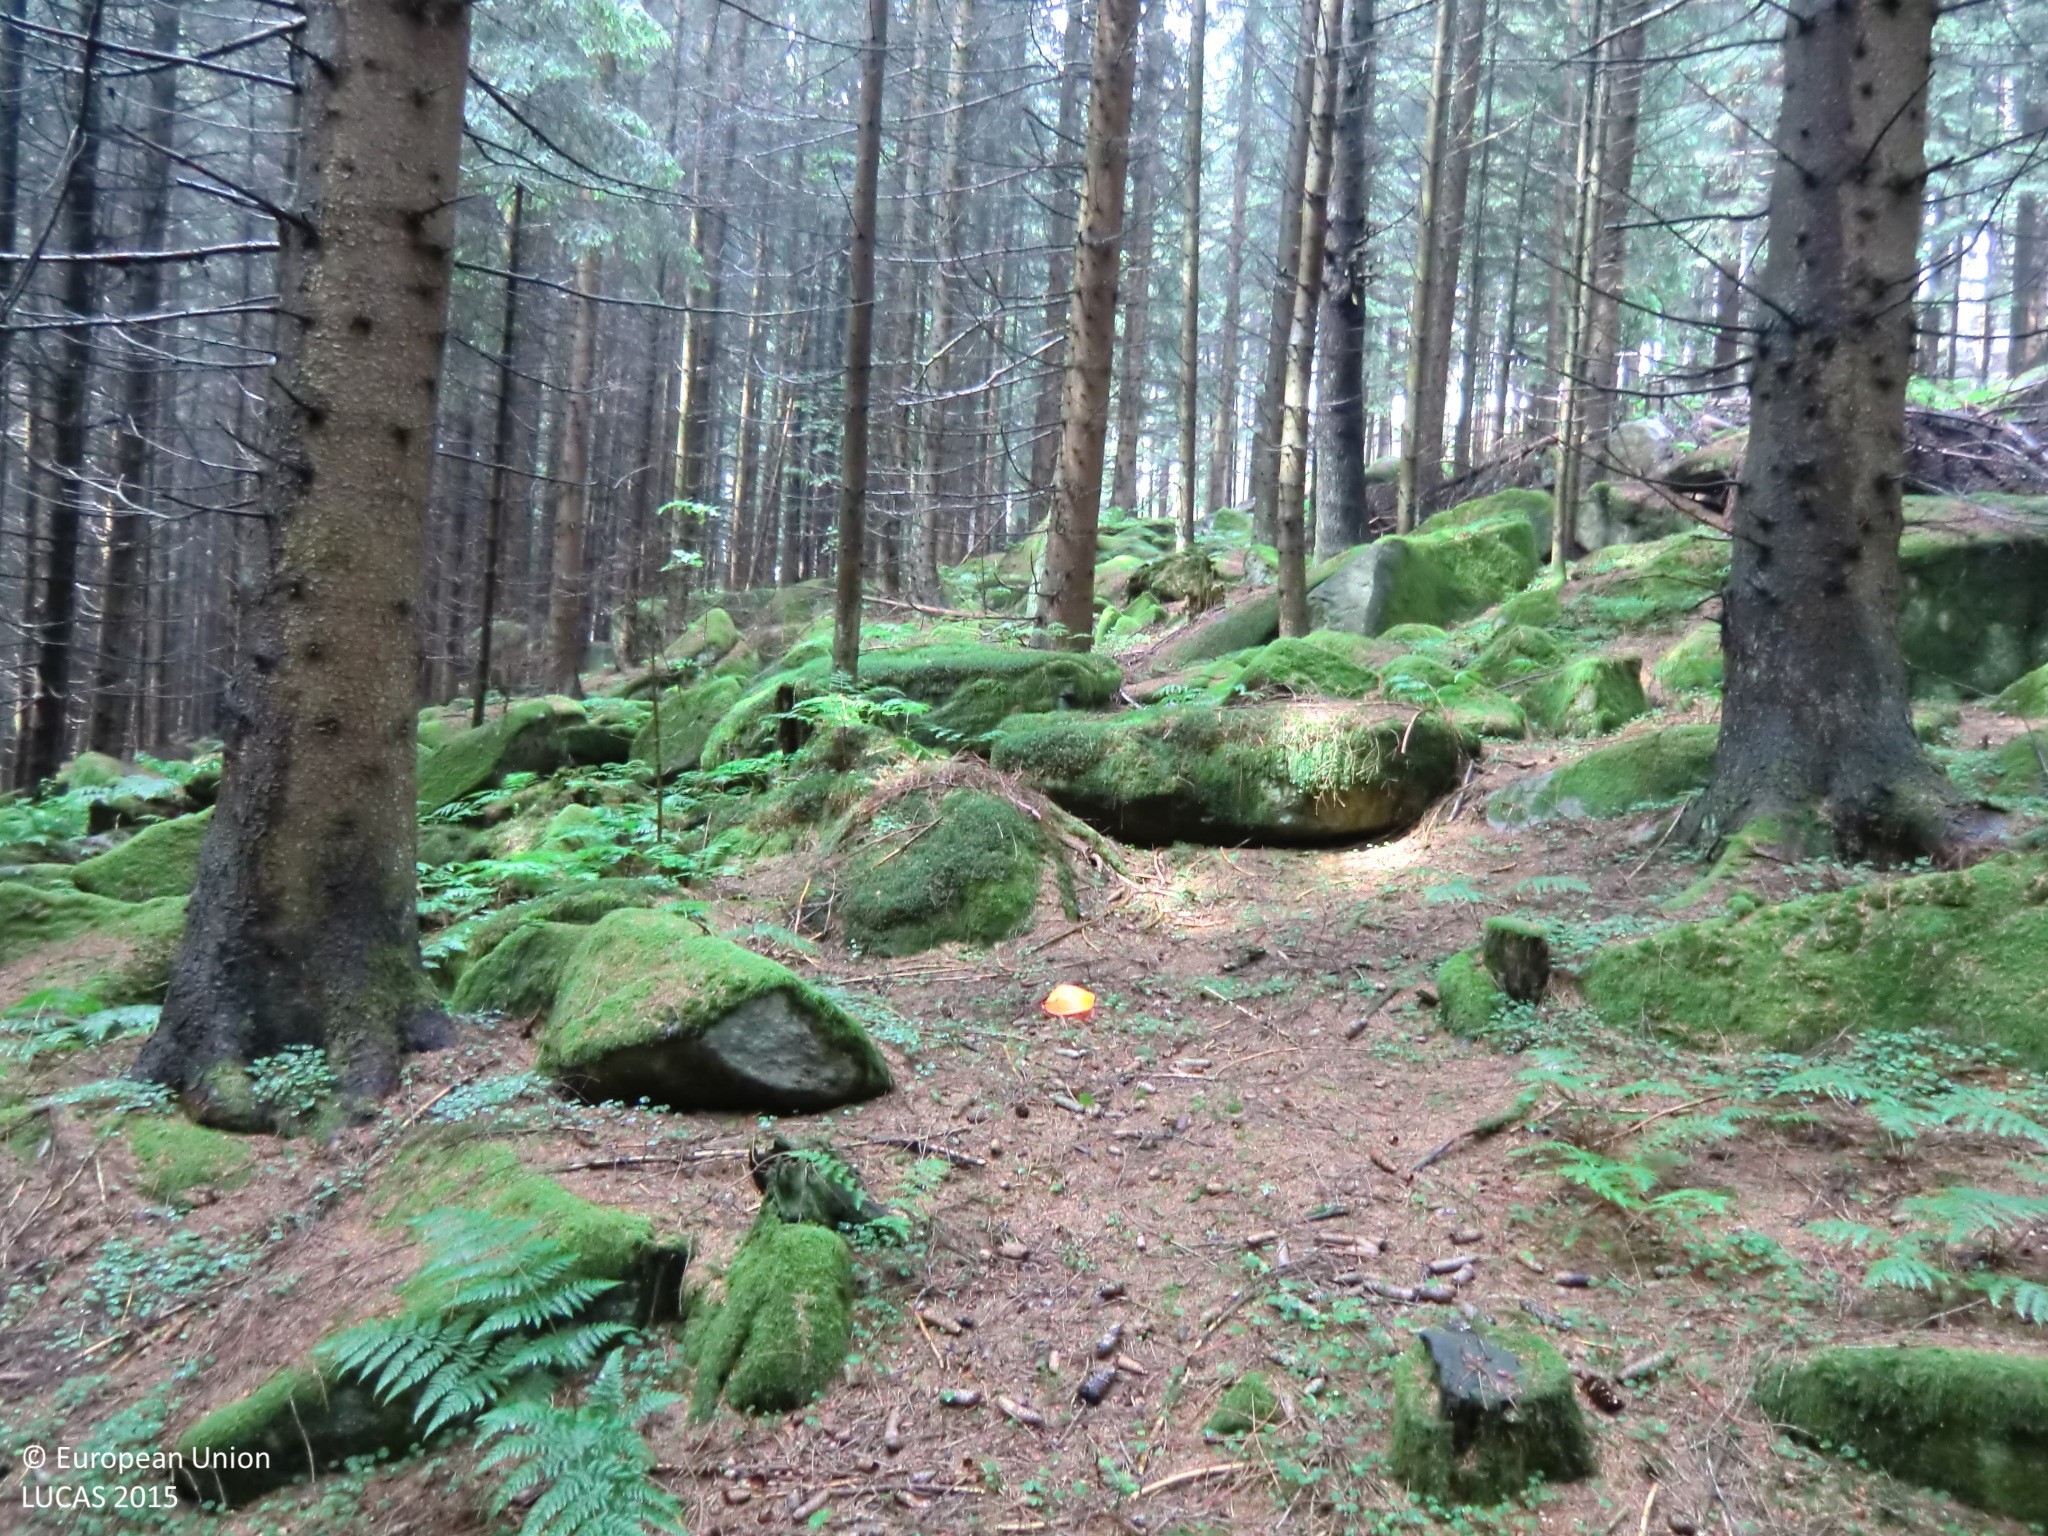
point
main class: Woodland
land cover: Spruce dominated coniferous woodland
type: hemiboreal forest and nemoral coniferous forest and mixed broadleaved-coniferous forest
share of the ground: > 75 %
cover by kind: coniferous forest trees 75 %, unconsolidated bare surface 15 %, herbaceous plants 10 %
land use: Forestry
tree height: > 5 m
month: June
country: AT
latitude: 48.5244
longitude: 14.5910
